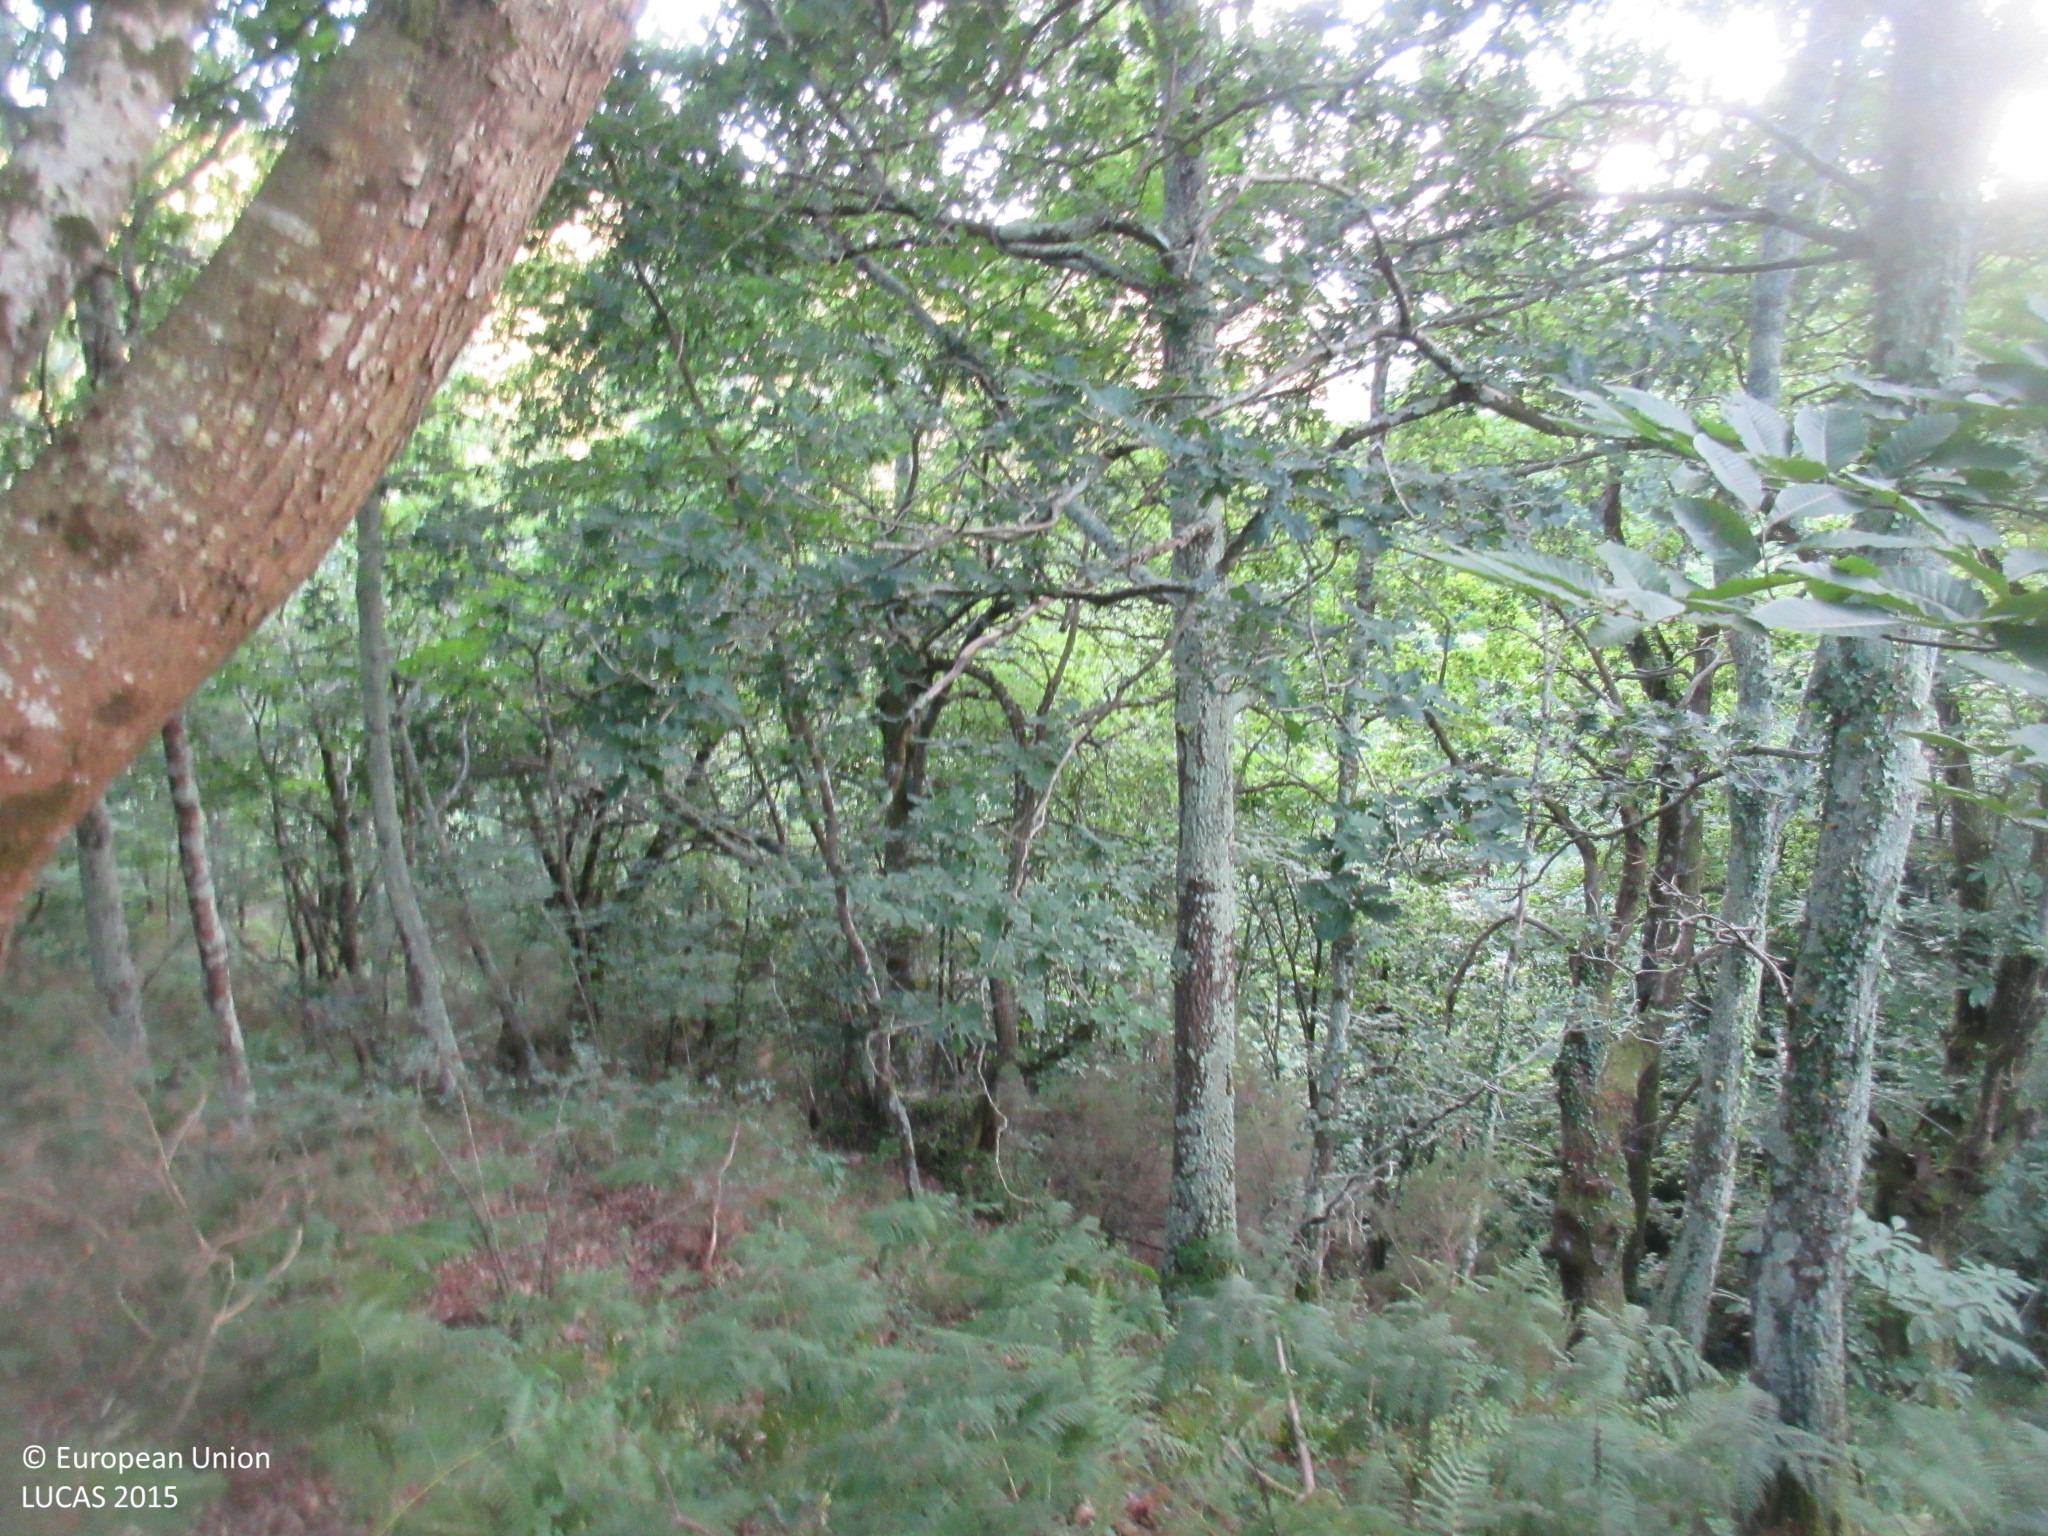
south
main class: Woodland
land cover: Broadleaved woodland
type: thermophilous deciduous forest
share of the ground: > 75 %
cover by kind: broadleaved forest trees 95 %, shrubs 5 %
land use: Forestry
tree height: > 5 m
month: July
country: ES
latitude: 43.3926
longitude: -5.0462
